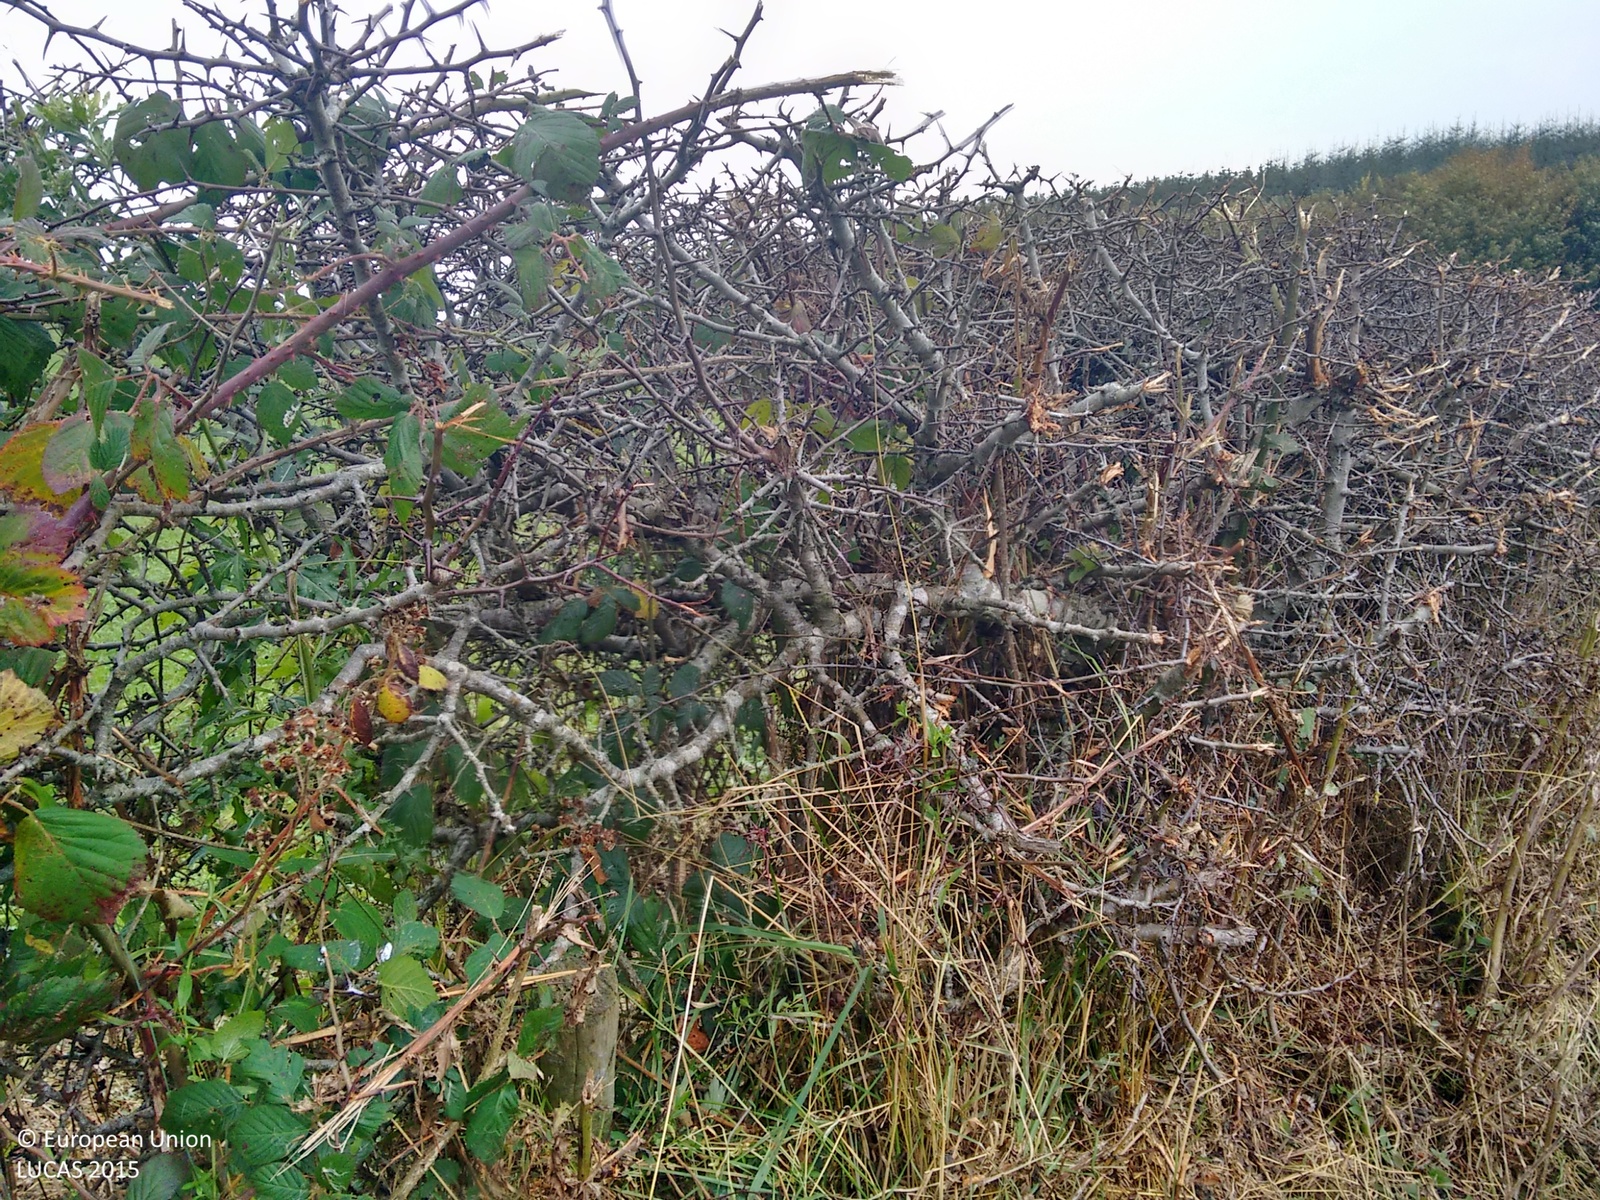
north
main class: Grassland
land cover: Grassland without tree/shrub cover
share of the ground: > 75 %
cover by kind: herbaceous plants 100 %
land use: Agriculture (excluding fallow land and kitchen gardens)
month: October
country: GB
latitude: 54.3267
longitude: -7.3577
